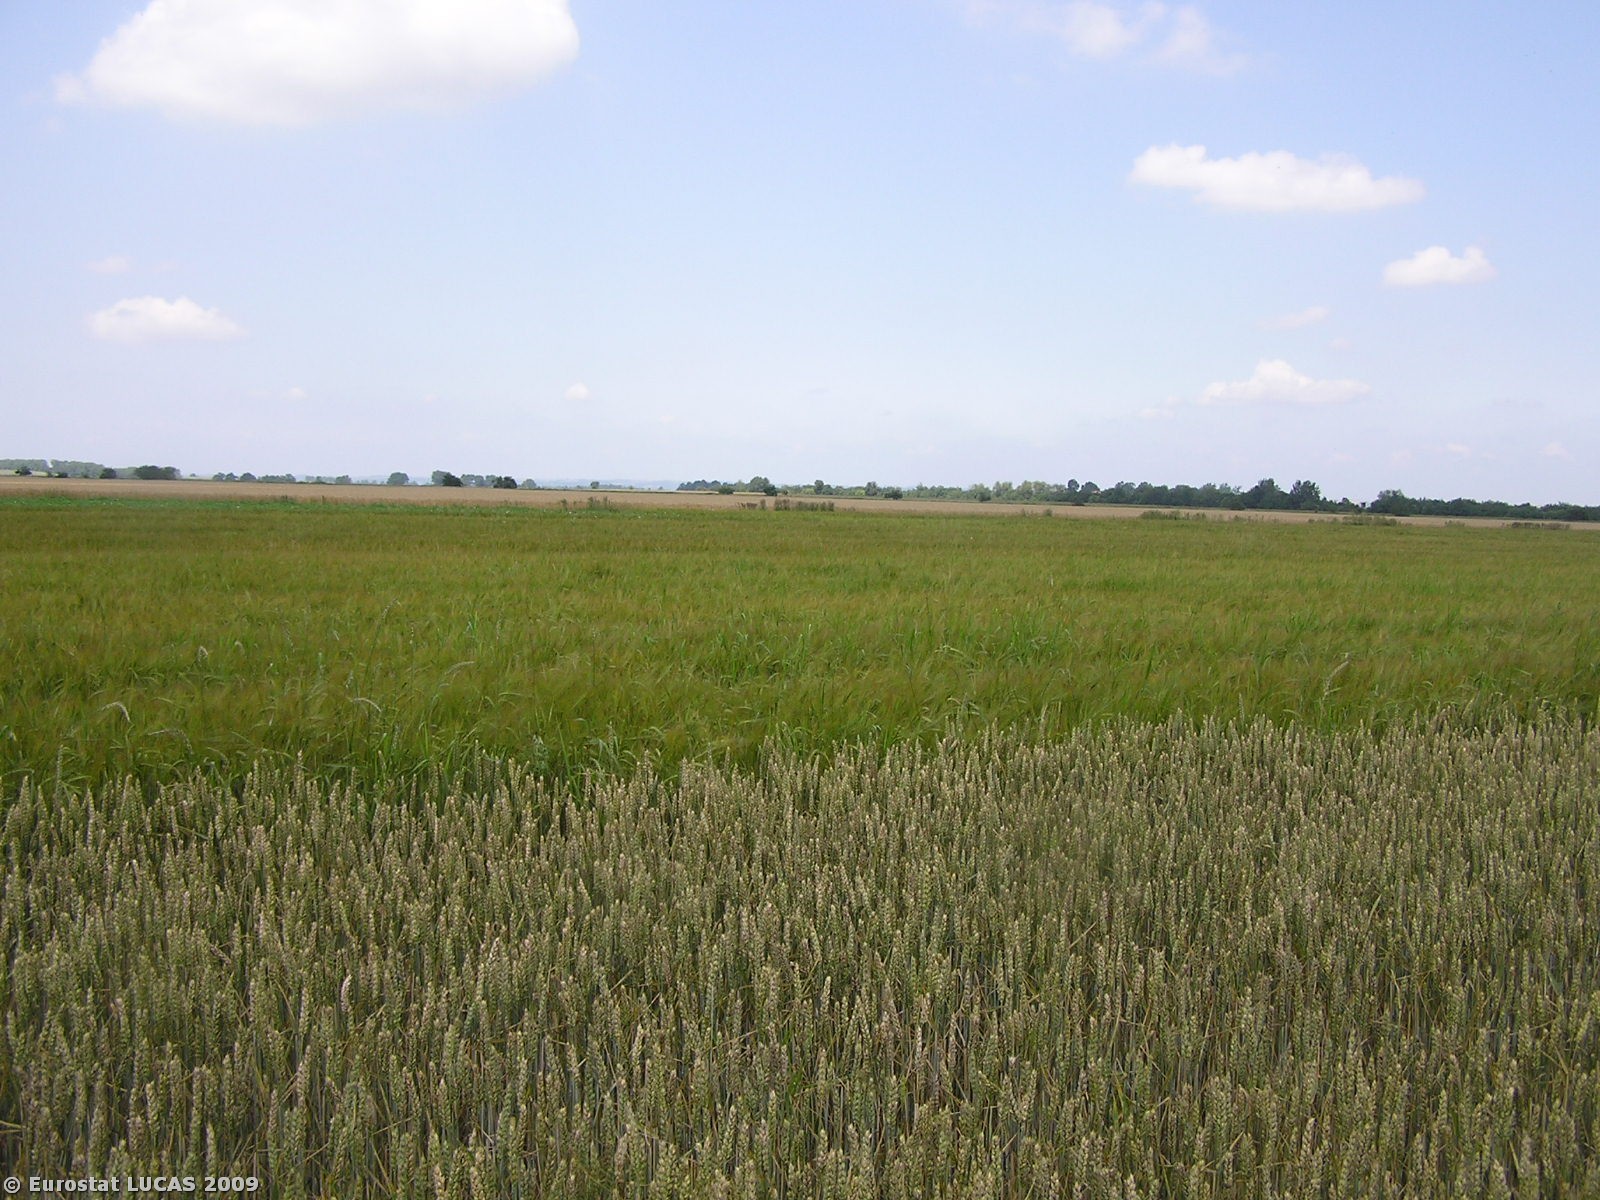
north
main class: Cropland
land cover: Common wheat
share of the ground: > 75 %
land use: Agriculture (excluding fallow land and kitchen gardens)
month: July
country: CZ
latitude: 50.3738
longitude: 17.1677
